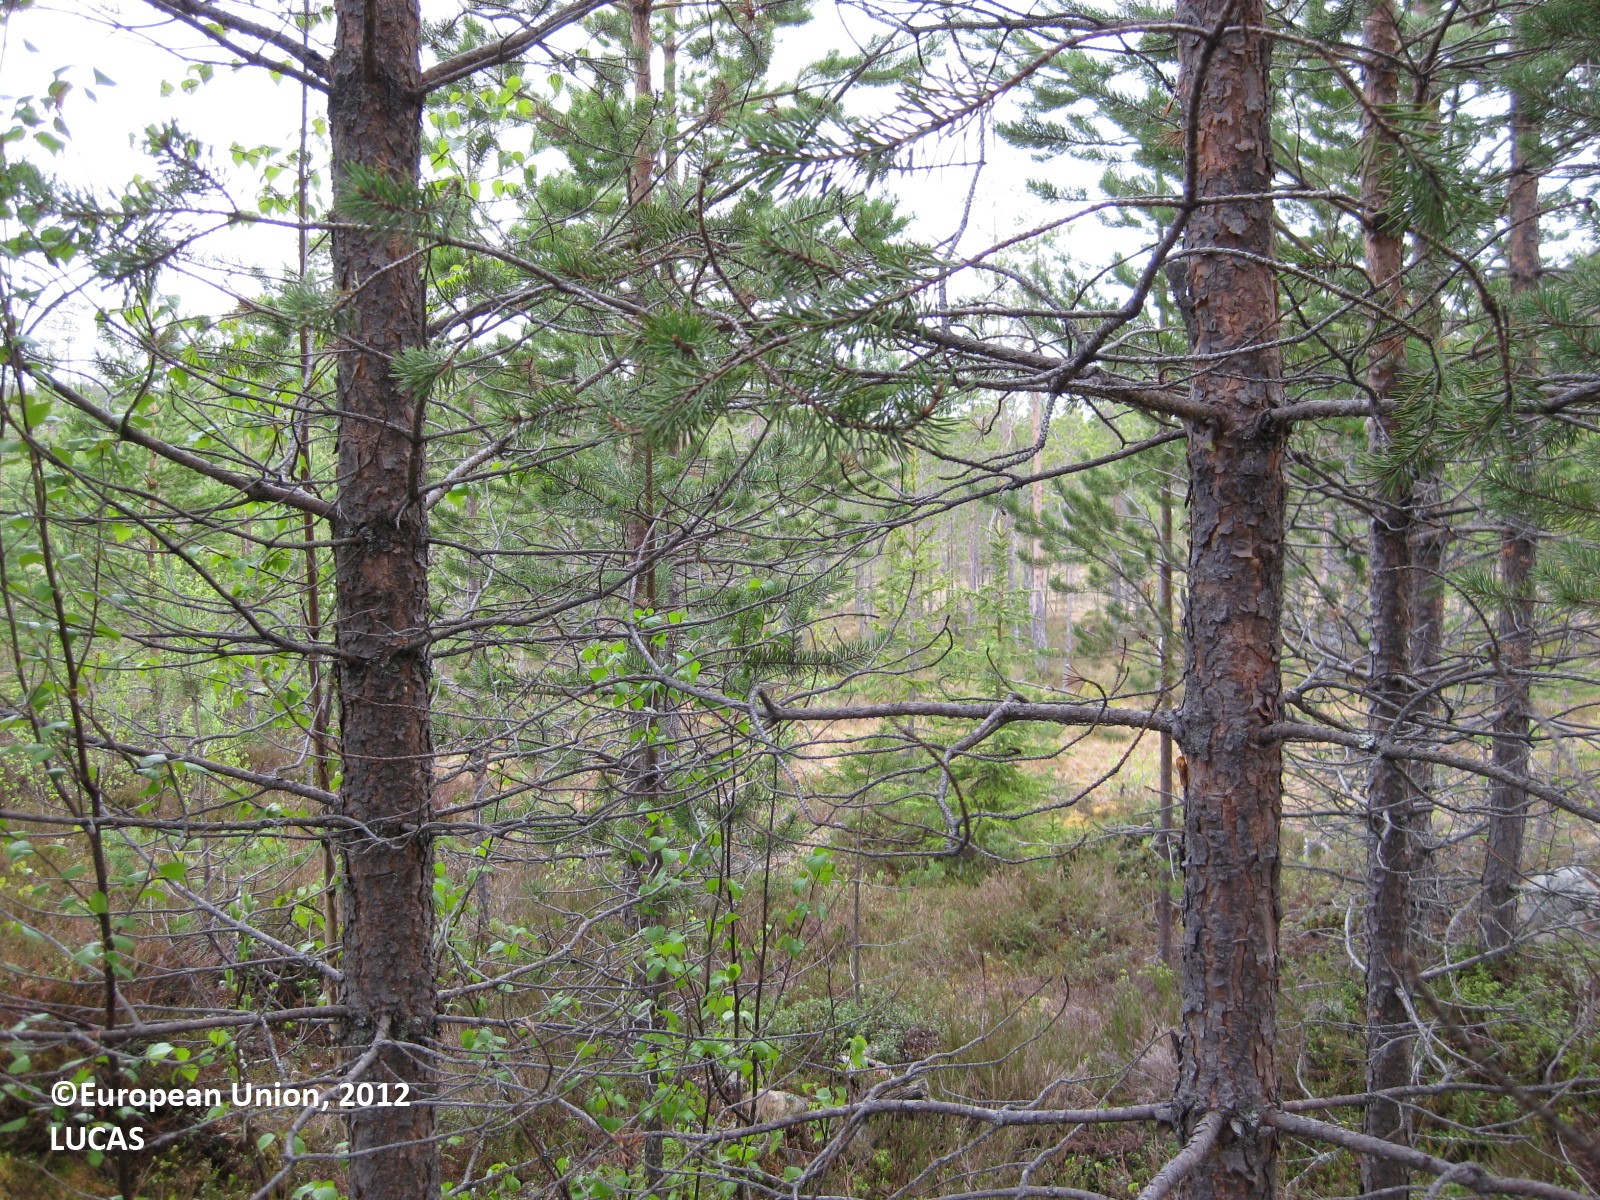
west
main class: Woodland
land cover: Pine dominated coniferous woodland
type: boreal forest
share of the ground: > 75 %
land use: Forestry
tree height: > 5 m
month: June
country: FI
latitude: 65.2637
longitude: 29.2322
